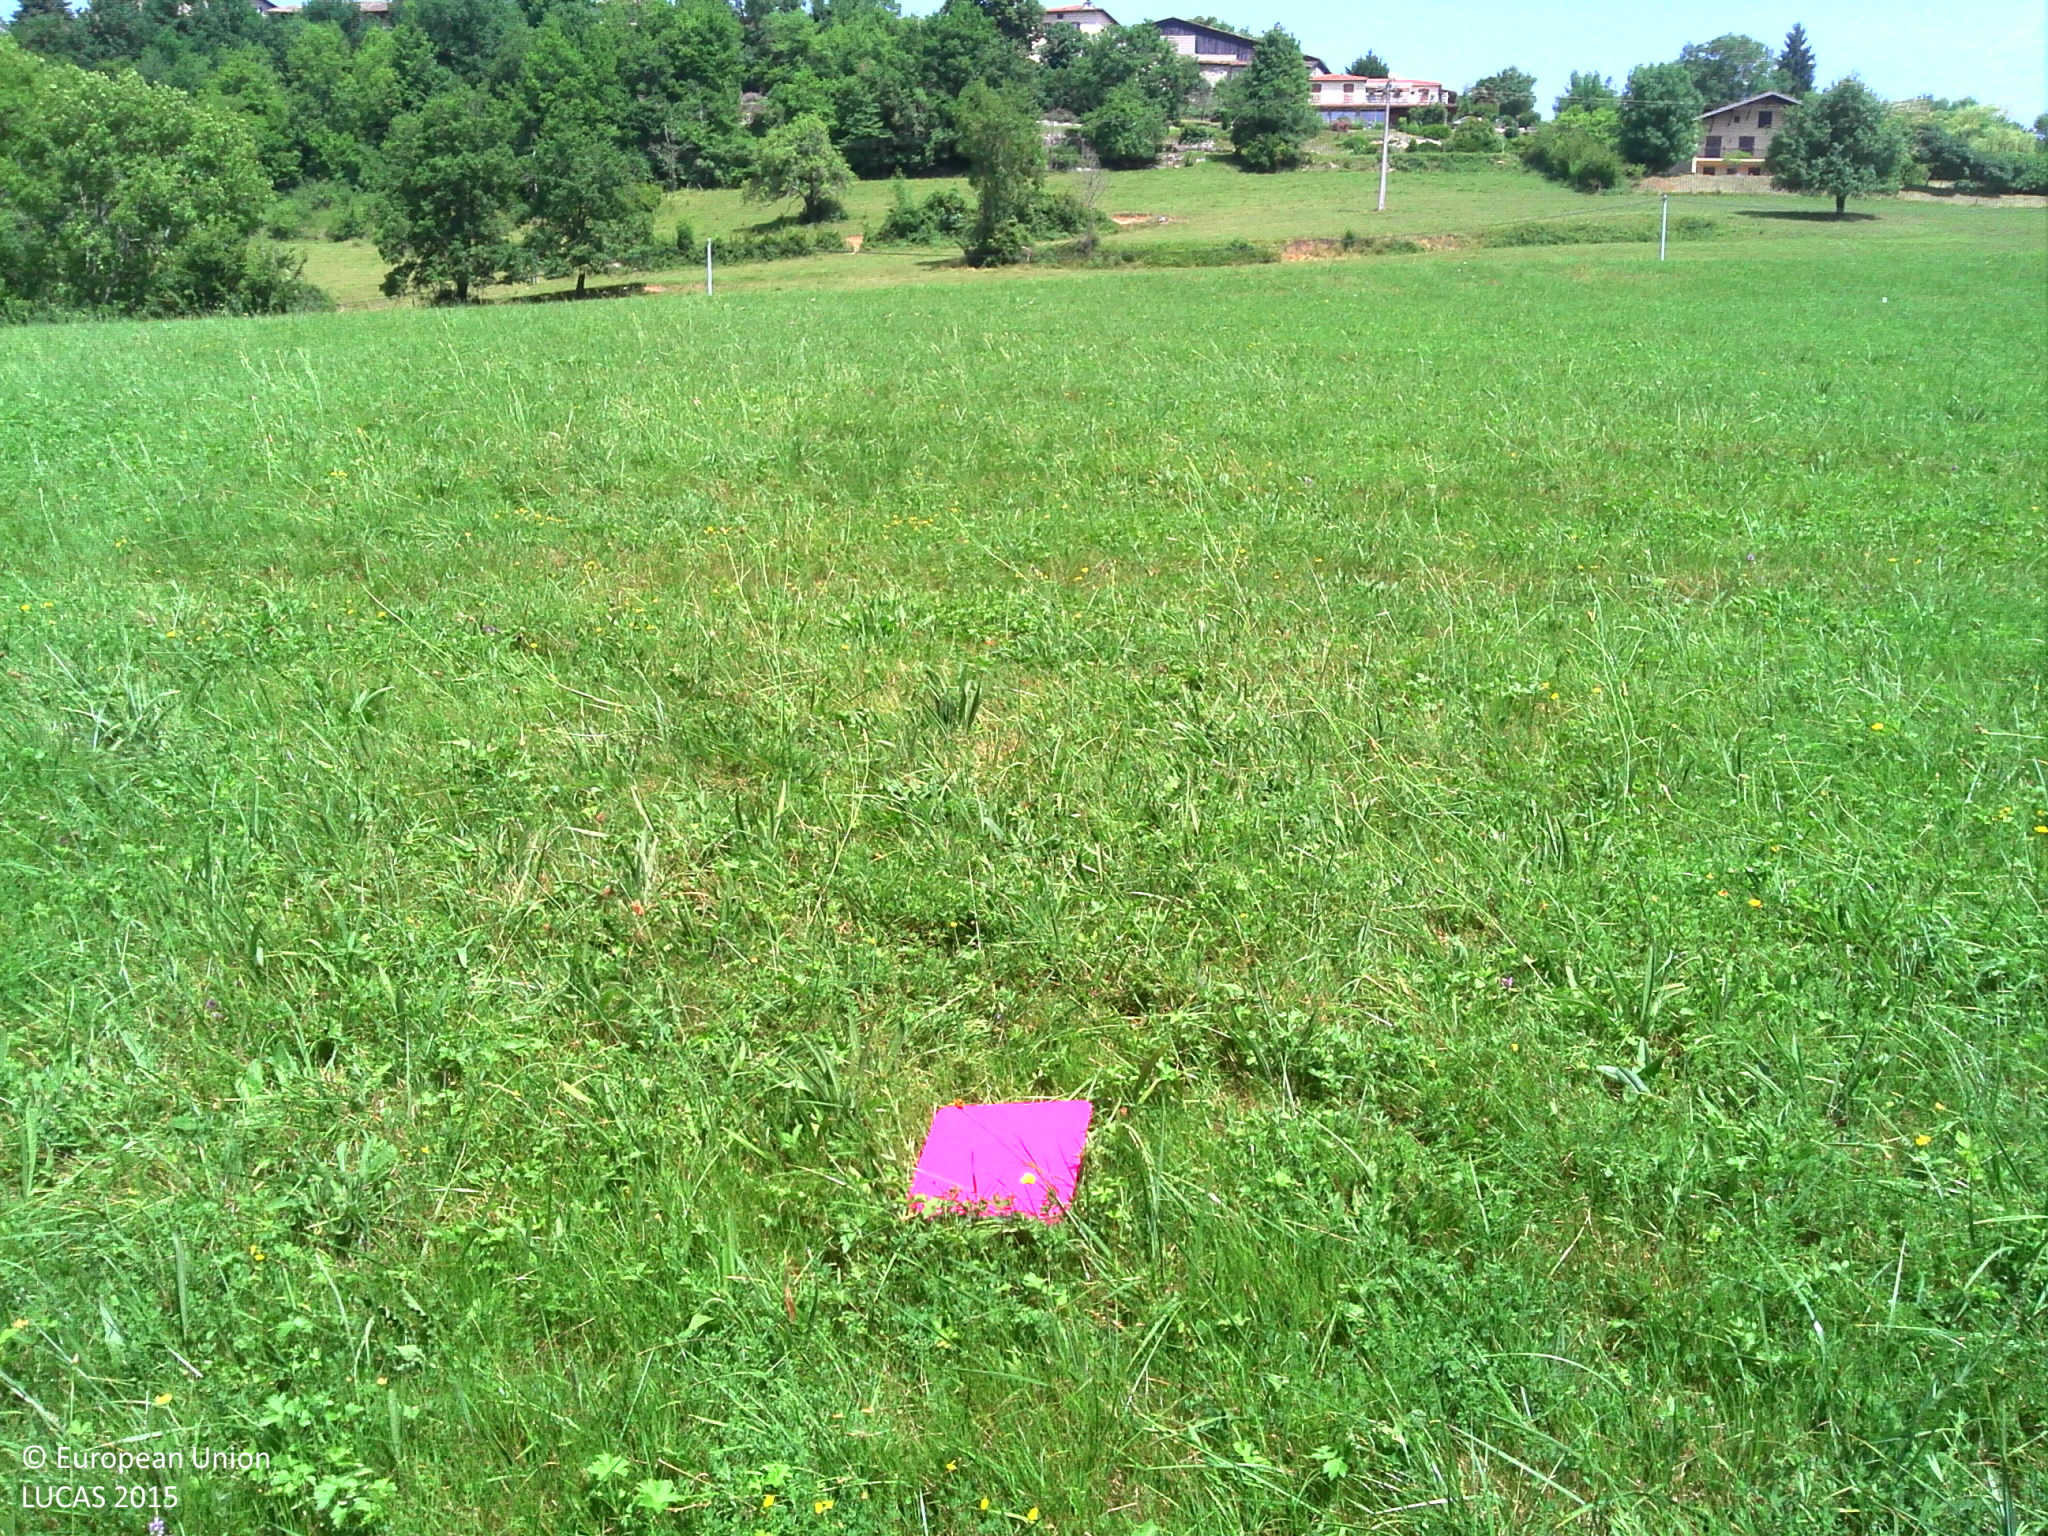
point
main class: Grassland
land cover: Grassland without tree/shrub cover
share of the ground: > 75 %
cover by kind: herbaceous plants 100 %
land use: Agriculture (excluding fallow land and kitchen gardens)
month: July
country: FR
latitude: 43.0690
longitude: 1.1994
